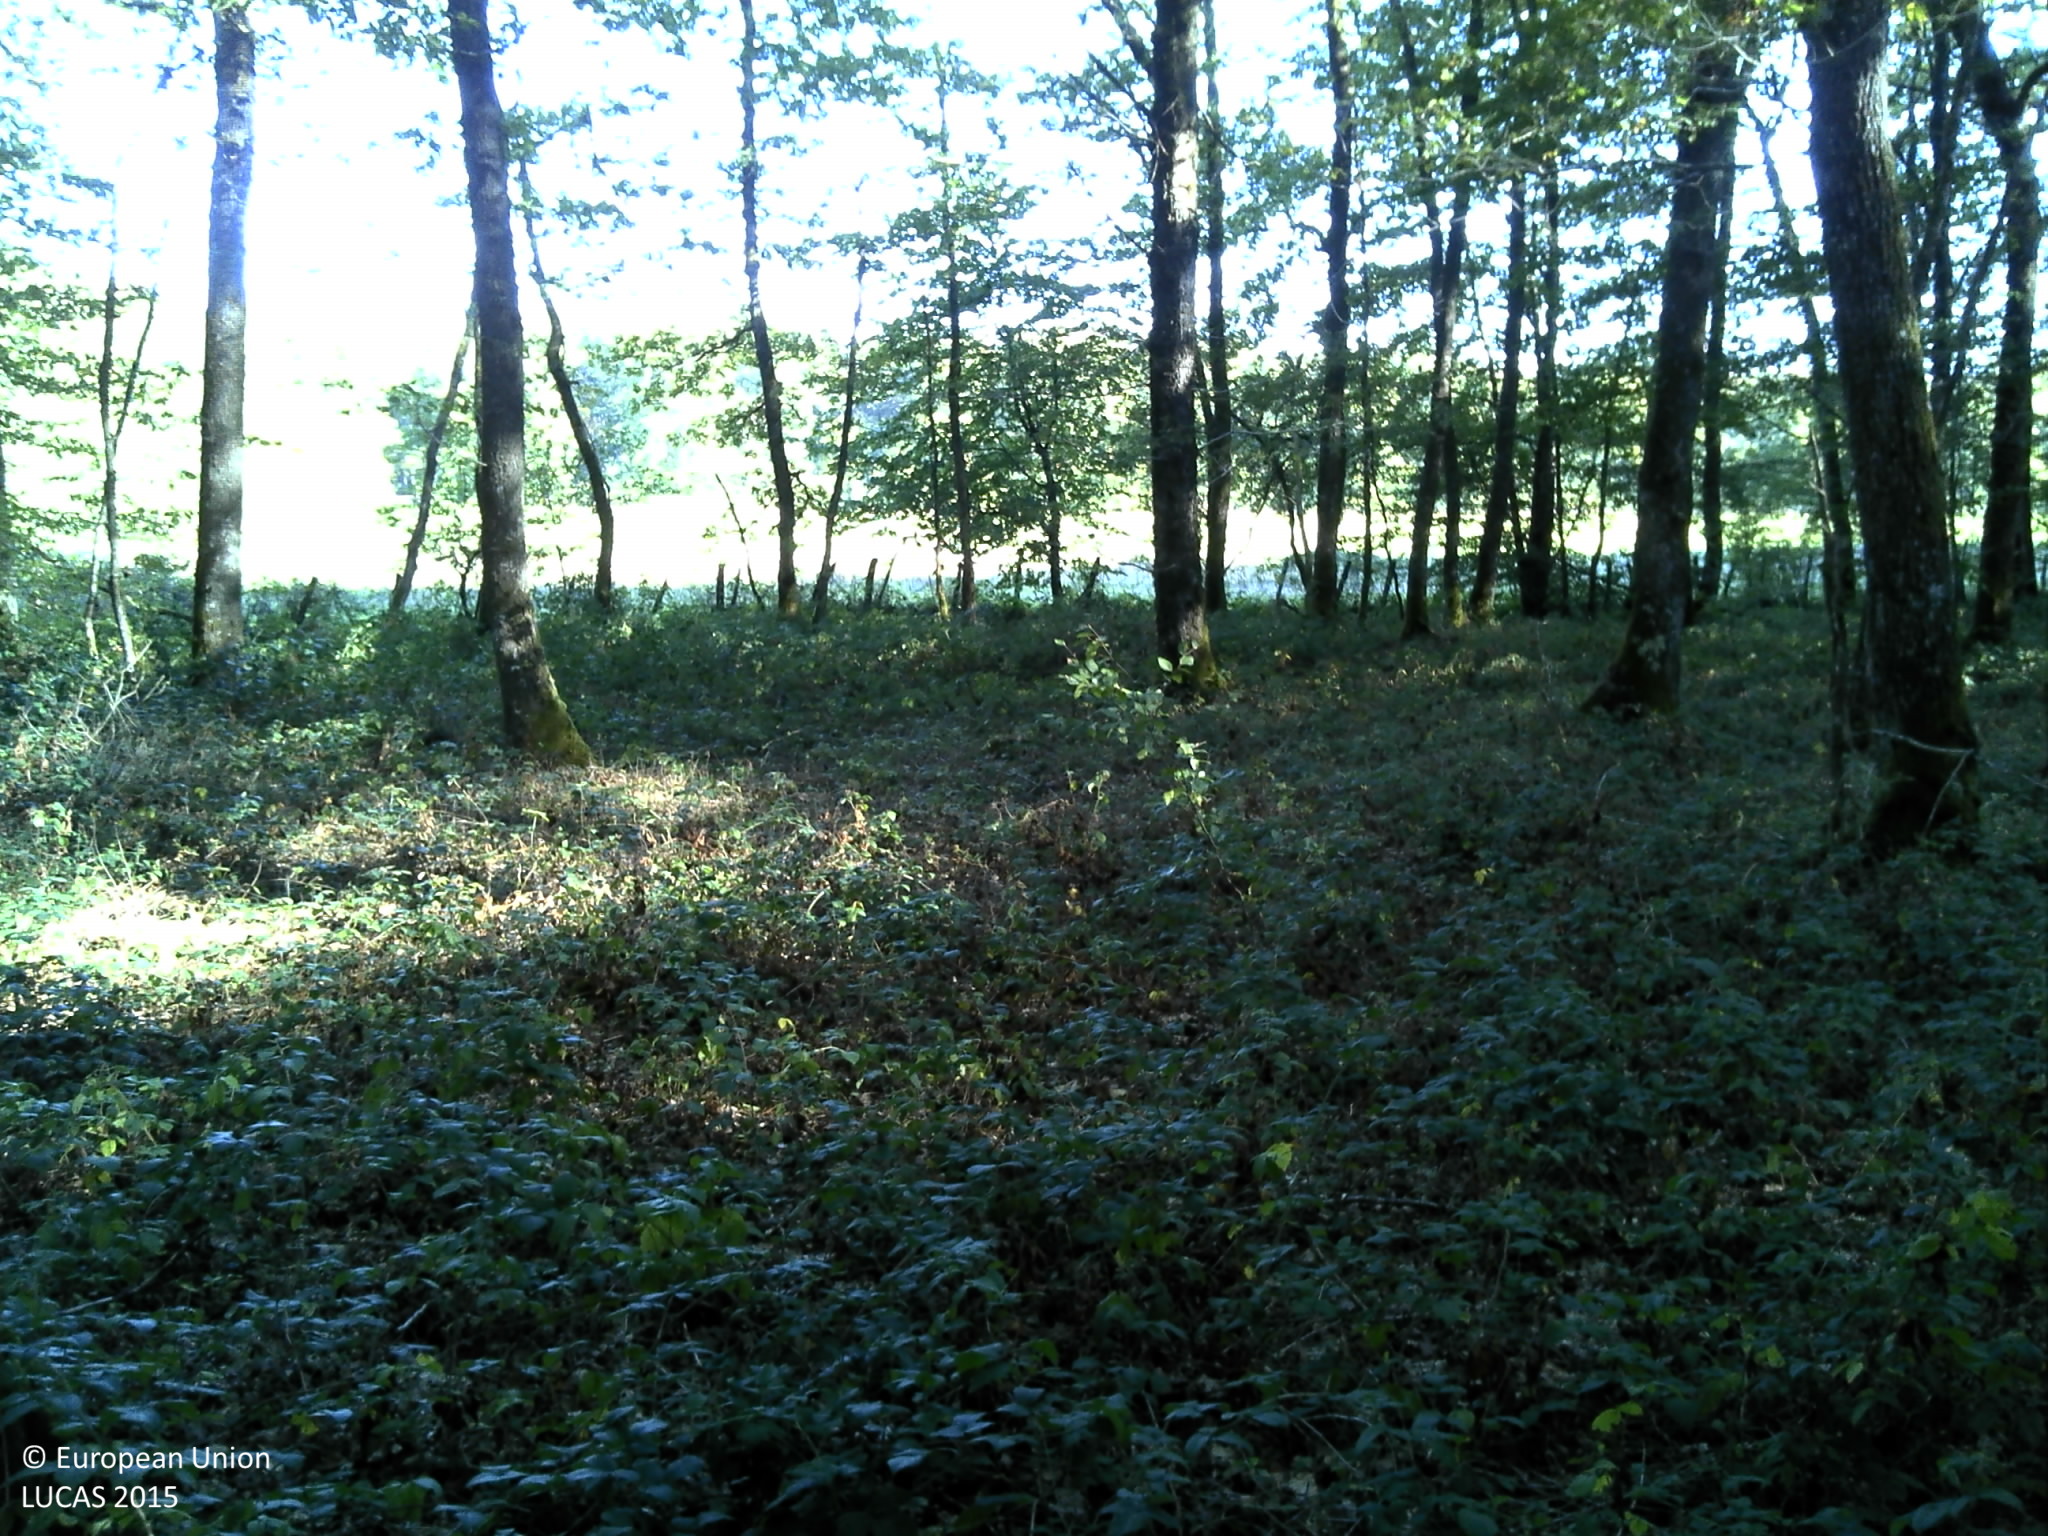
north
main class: Woodland
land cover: Broadleaved woodland
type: mesophytic deciduous forest
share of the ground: > 75 %
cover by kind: broadleaved forest trees 85 %, herbaceous plants 5 %, lichens and mosses 5 %
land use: Forestry
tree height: > 5 m
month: September
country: FR
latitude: 46.9109
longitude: 4.4465
